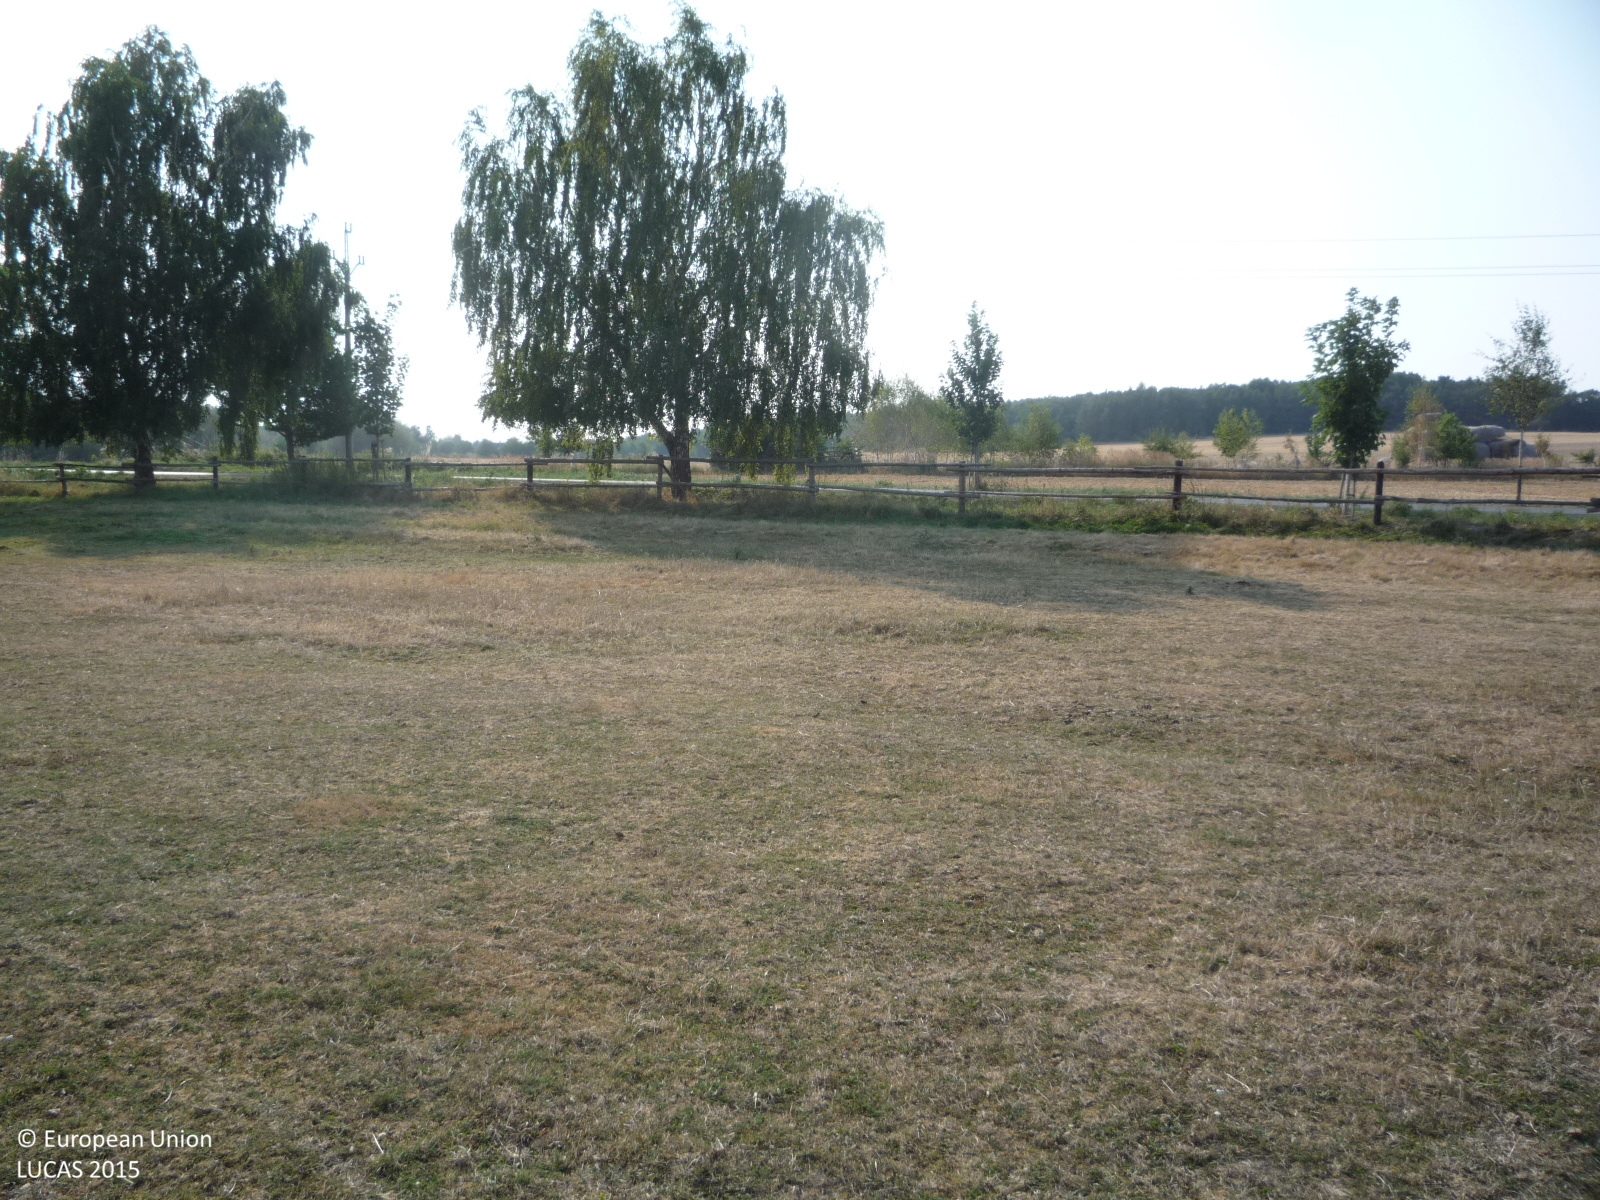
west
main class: Grassland
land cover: Grassland without tree/shrub cover
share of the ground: > 75 %
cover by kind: herbaceous plants 95 %, unconsolidated bare surface 5 %
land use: Agriculture (excluding fallow land and kitchen gardens)
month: August
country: CZ
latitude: 49.9186
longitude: 14.4165
